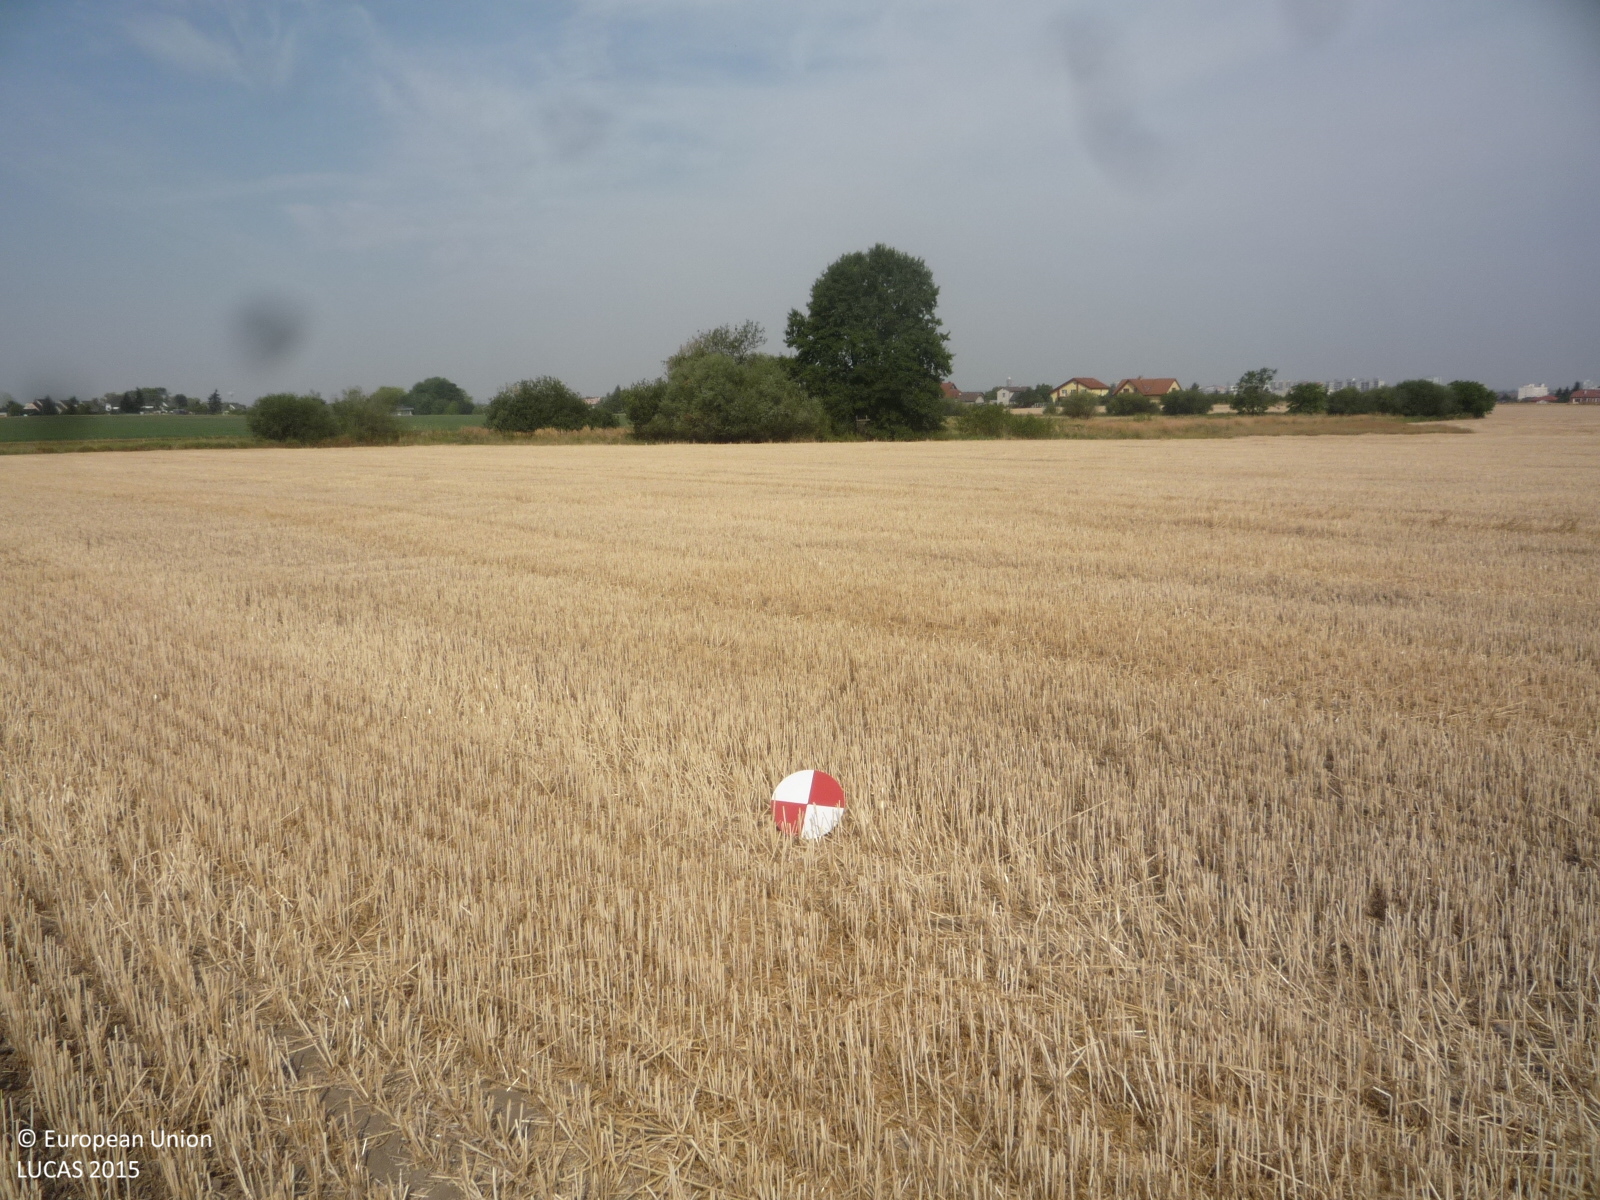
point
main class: Cropland
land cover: Common wheat
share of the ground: 25 - 50 %
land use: Agriculture (excluding fallow land and kitchen gardens)
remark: Harvested field
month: August
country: CZ
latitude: 49.9882
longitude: 14.4788
